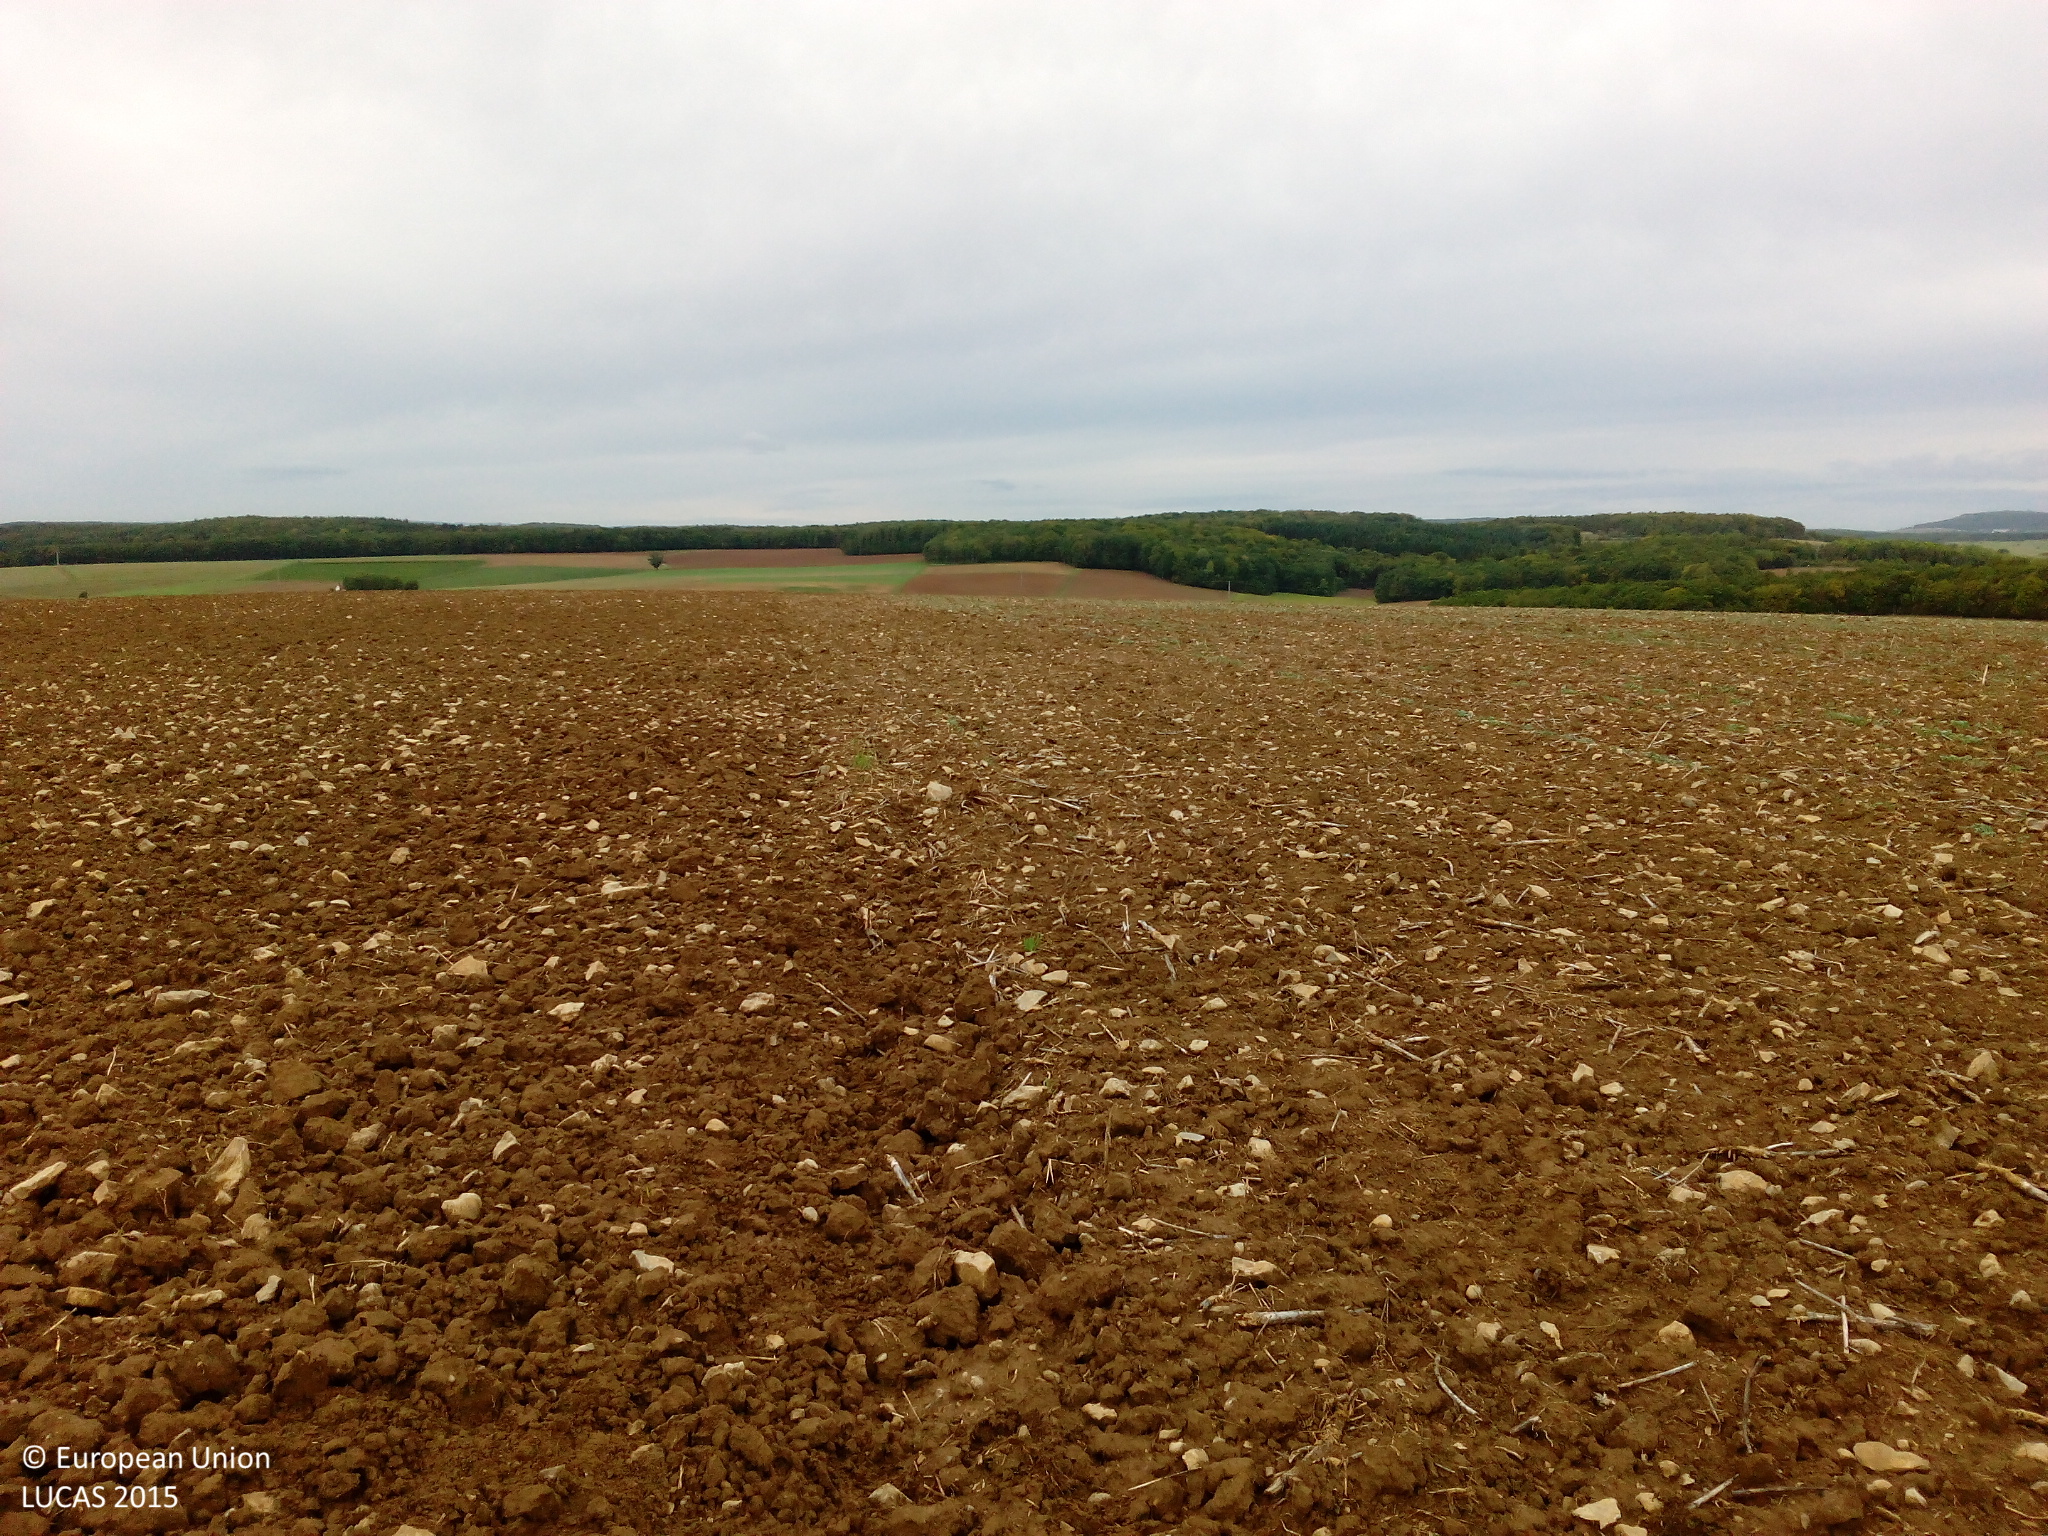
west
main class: Cropland
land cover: Rape and turnip rape
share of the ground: < 10 %
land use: Agriculture (excluding fallow land and kitchen gardens)
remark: Harvested field
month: September
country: DE
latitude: 50.0583
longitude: 9.9302
